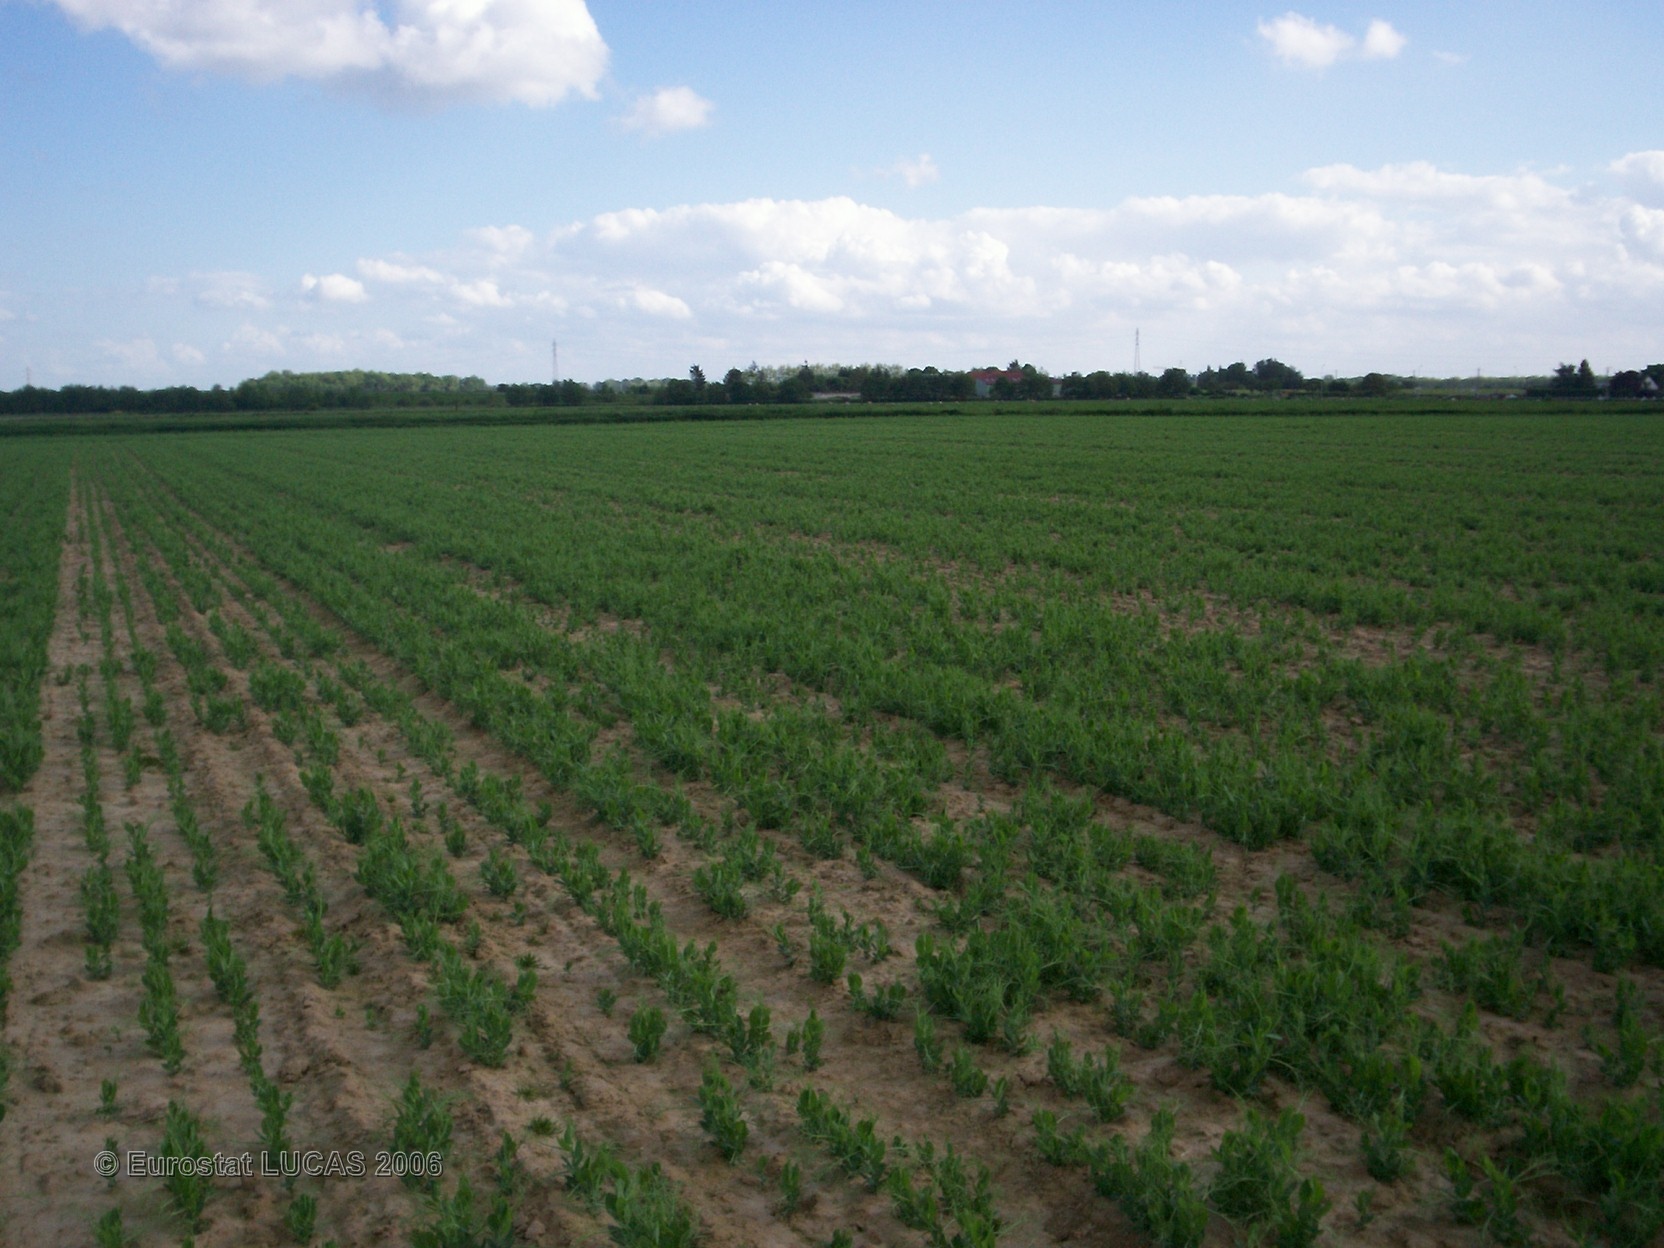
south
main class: Cropland
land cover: Dry pulses
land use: Agriculture (excluding fallow land and kitchen gardens)
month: May
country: FR
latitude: 48.7464
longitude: 2.7962
